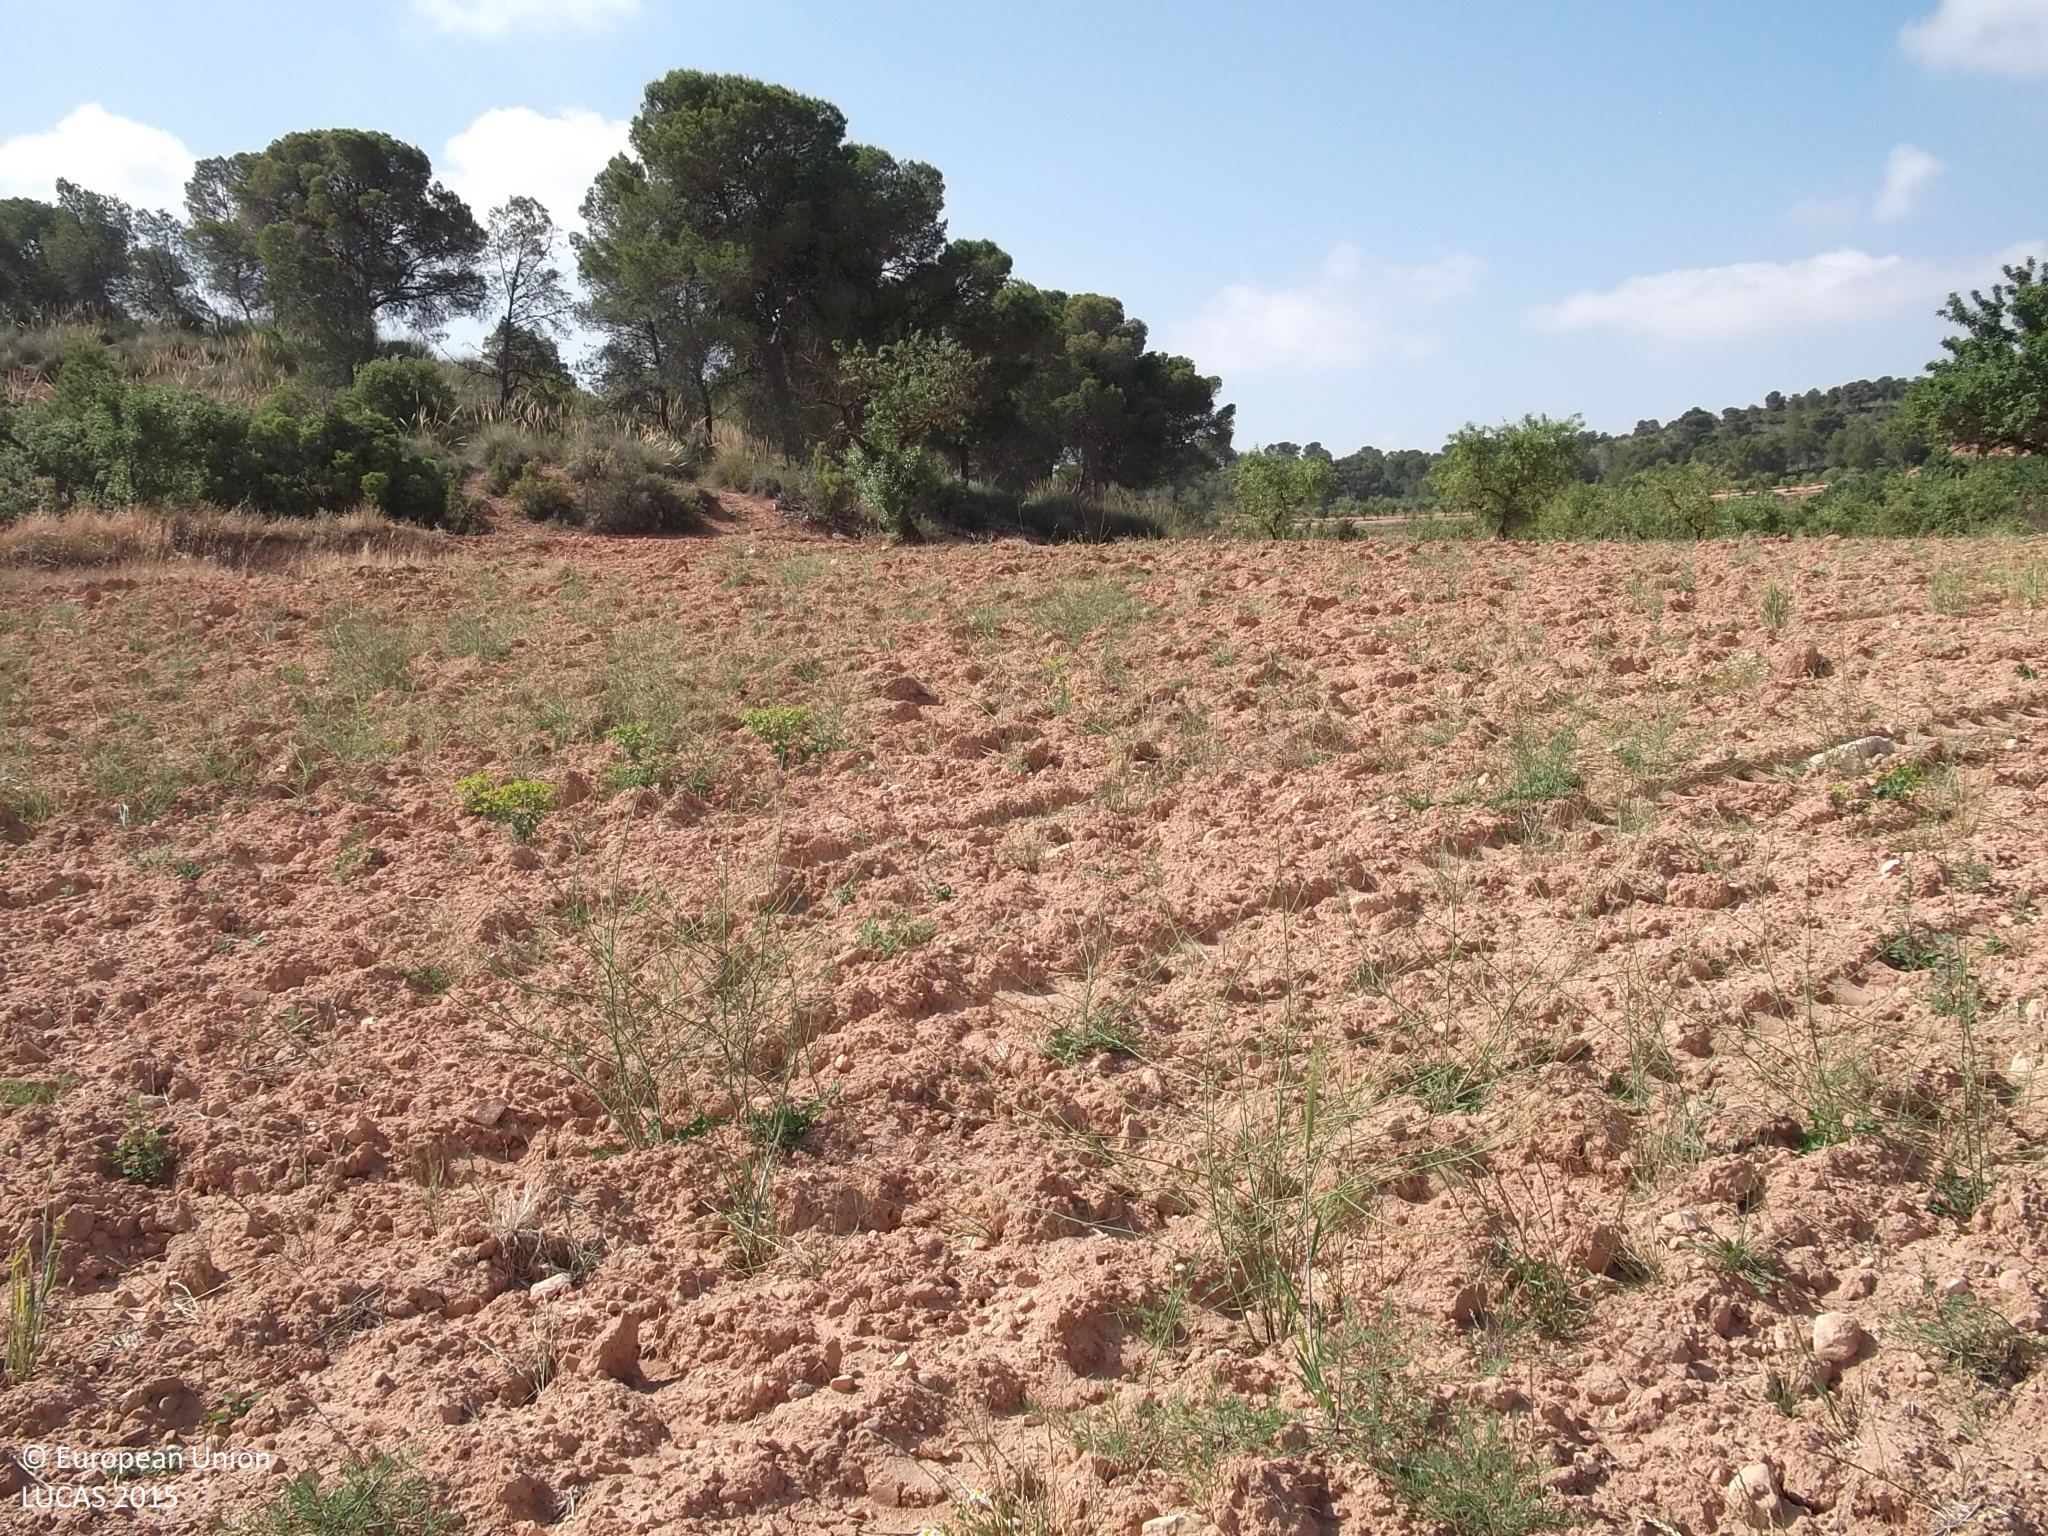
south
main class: Grassland
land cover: Spontaneously vegetated surfaces
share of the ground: 25 - 50 %
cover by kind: unconsolidated bare surface 75 %, herbaceous plants 25 %
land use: Fallow land
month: May
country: ES
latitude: 38.4604
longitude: -1.4629
